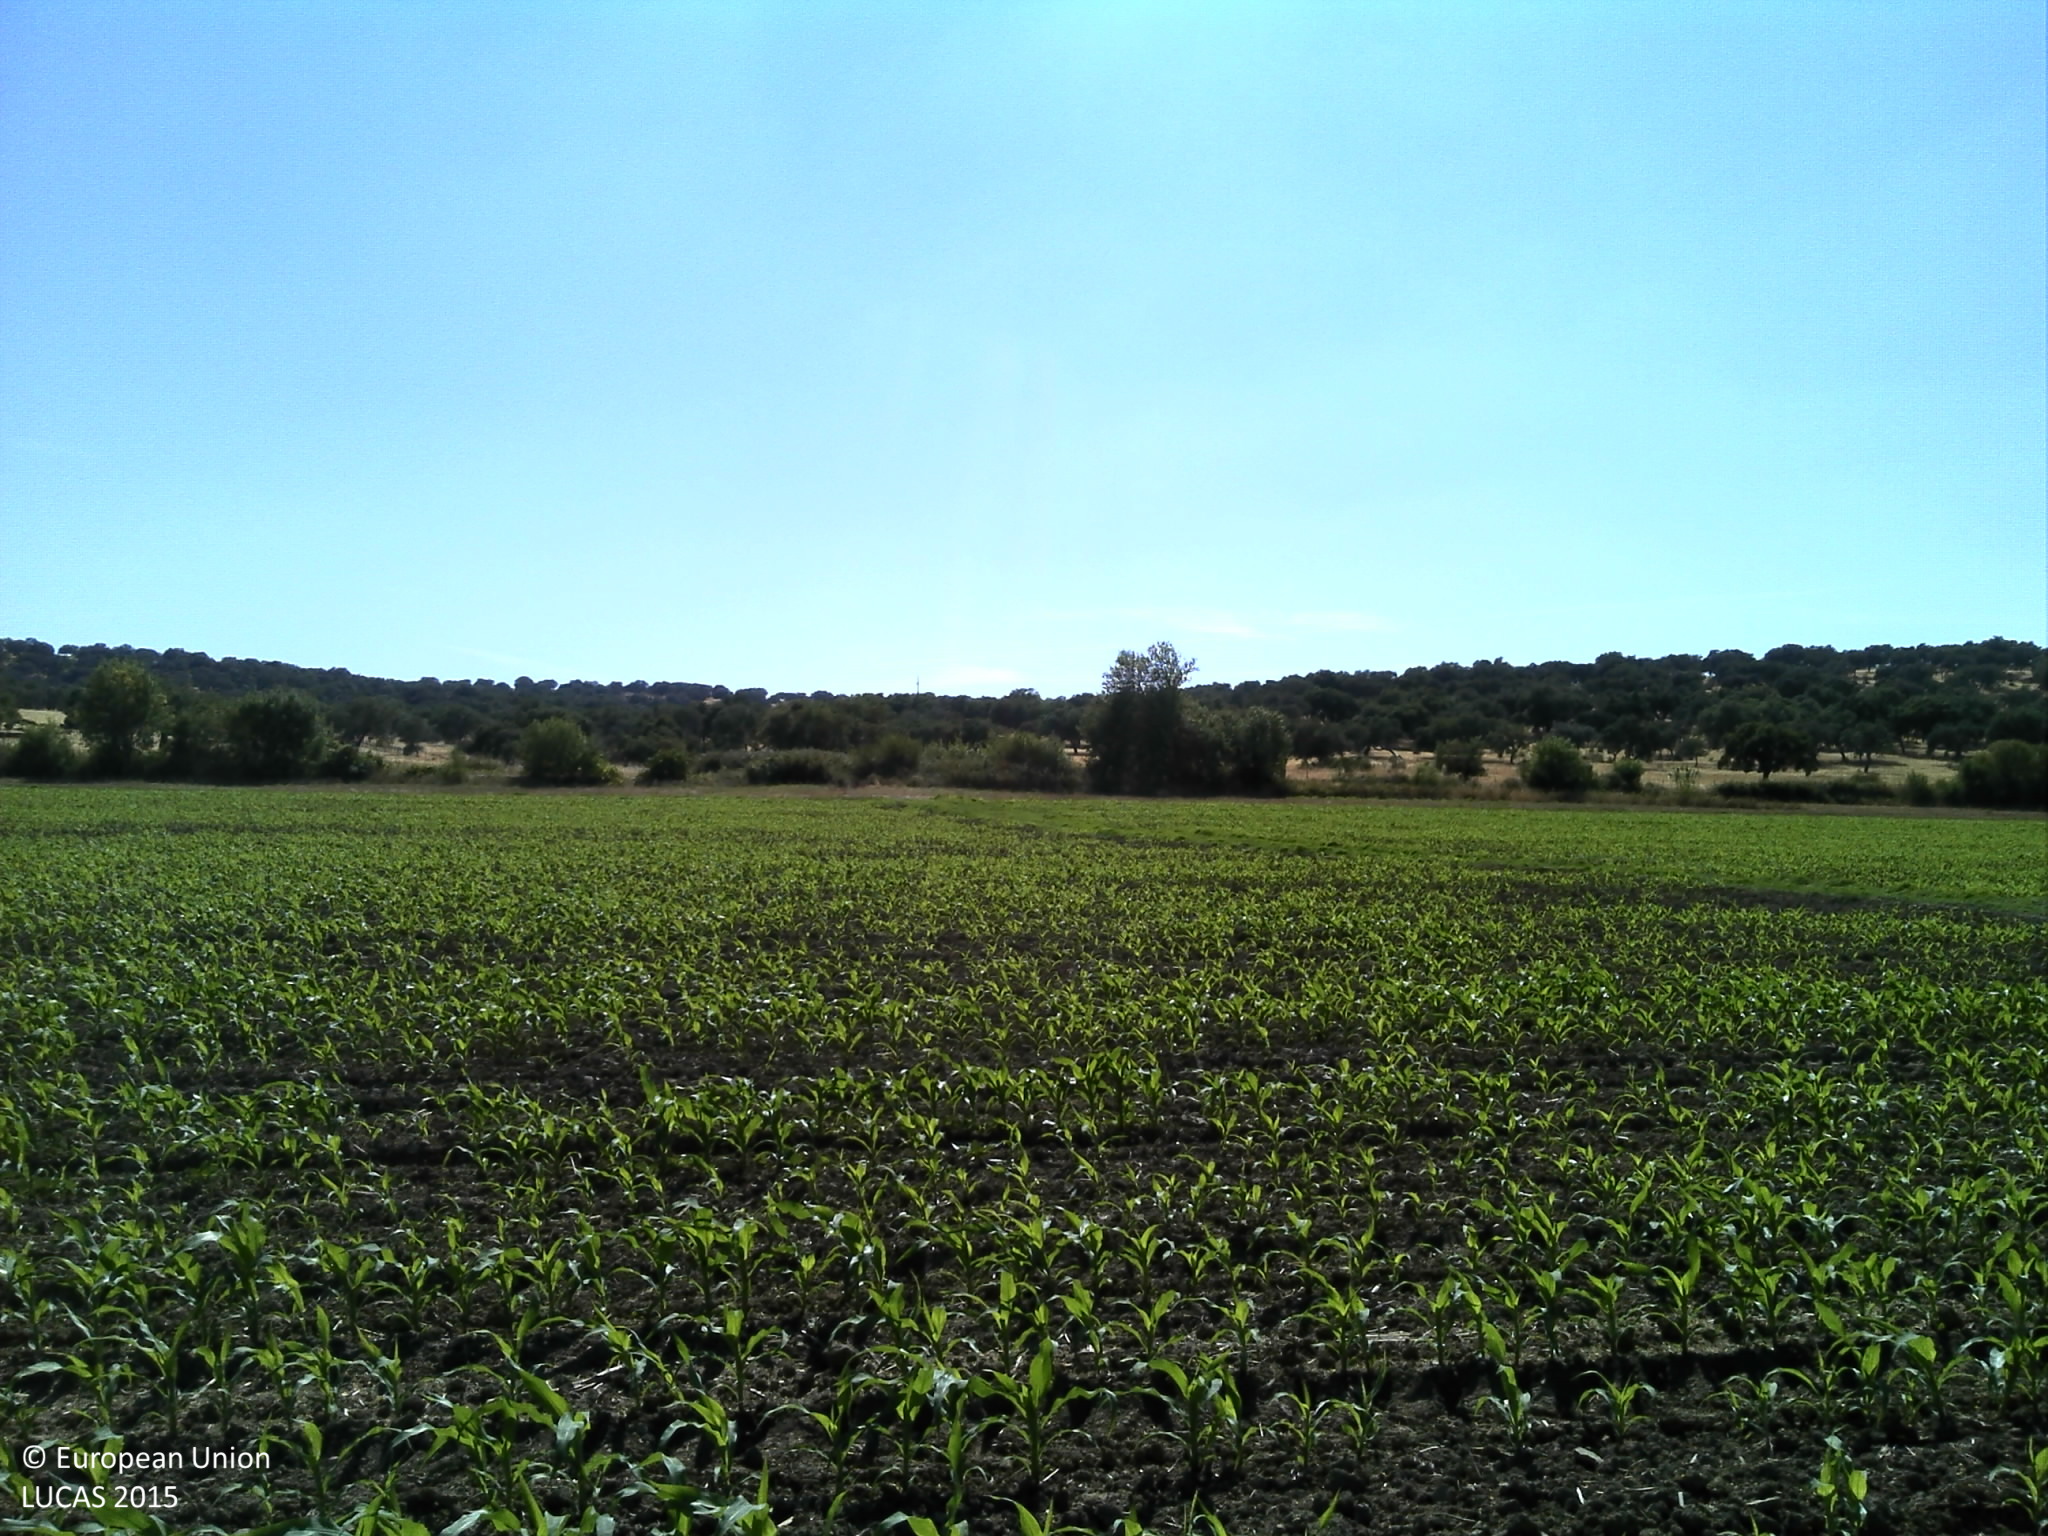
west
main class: Cropland
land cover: Maize
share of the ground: 10 - 25 %
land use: Agriculture (excluding fallow land and kitchen gardens)
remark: Temporary dry
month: June
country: PT
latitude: 38.3186
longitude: -8.1463
